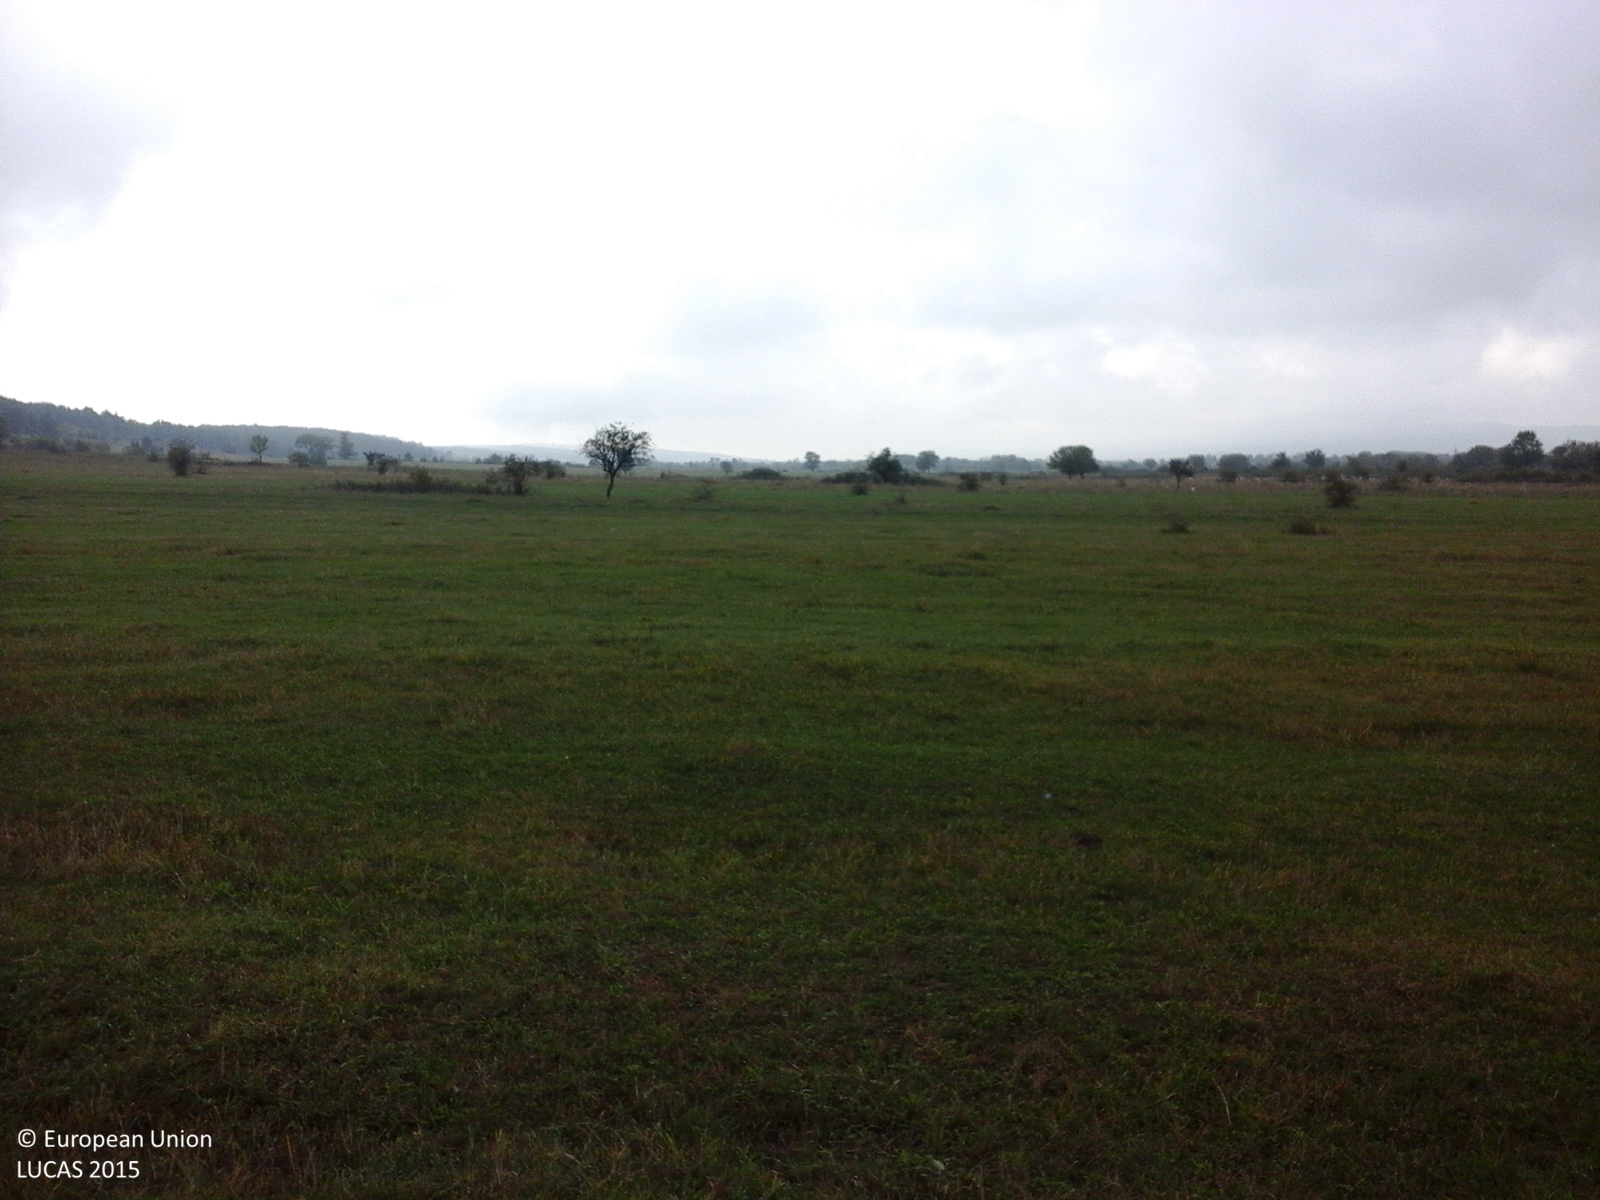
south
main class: Grassland
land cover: Grassland without tree/shrub cover
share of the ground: > 75 %
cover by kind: herbaceous plants 100 %
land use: Agriculture (excluding fallow land and kitchen gardens)
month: September
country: RO
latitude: 45.1146
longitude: 23.1579
